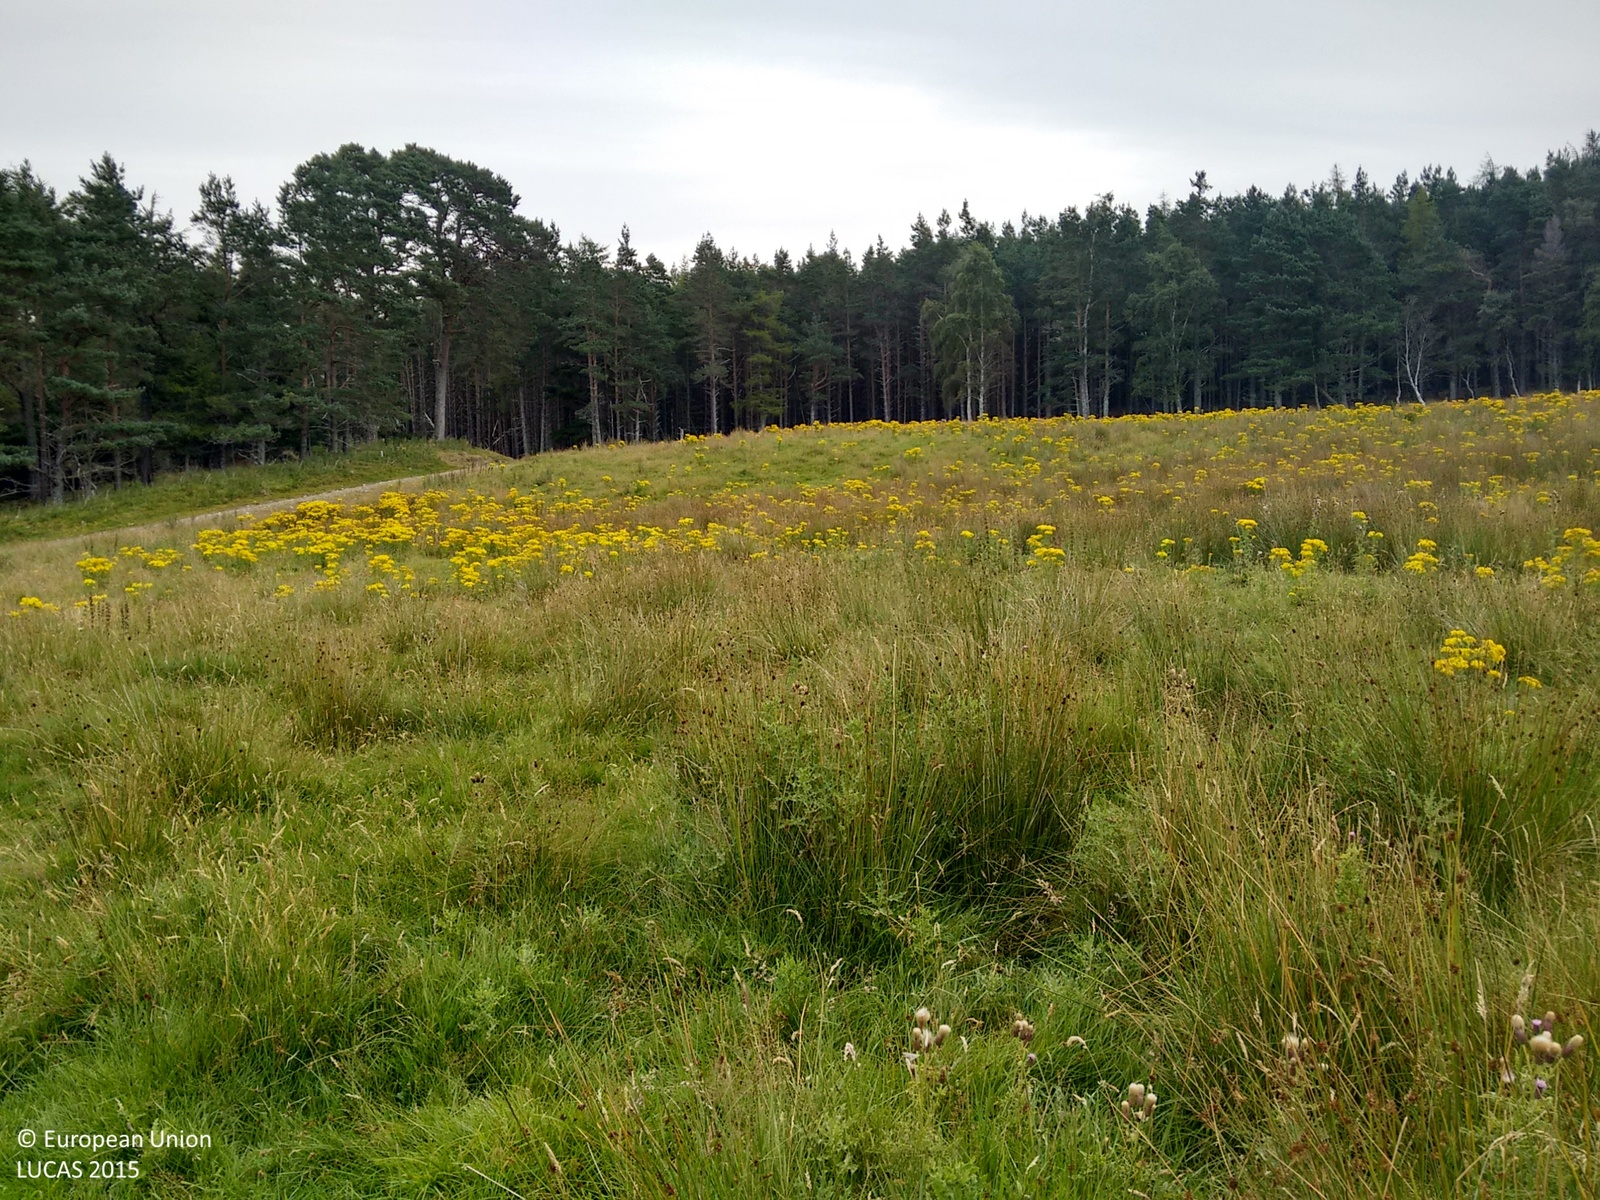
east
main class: Grassland
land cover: Grassland without tree/shrub cover
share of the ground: > 75 %
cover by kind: herbaceous plants 100 %
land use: Agriculture (excluding fallow land and kitchen gardens)
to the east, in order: Grassland without tree/shrub cover; Tracks; Pine dominated mixed woodland; Rivers and streams; Pine dominated mixed woodland
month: September
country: GB
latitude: 57.8776
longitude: -4.4024
